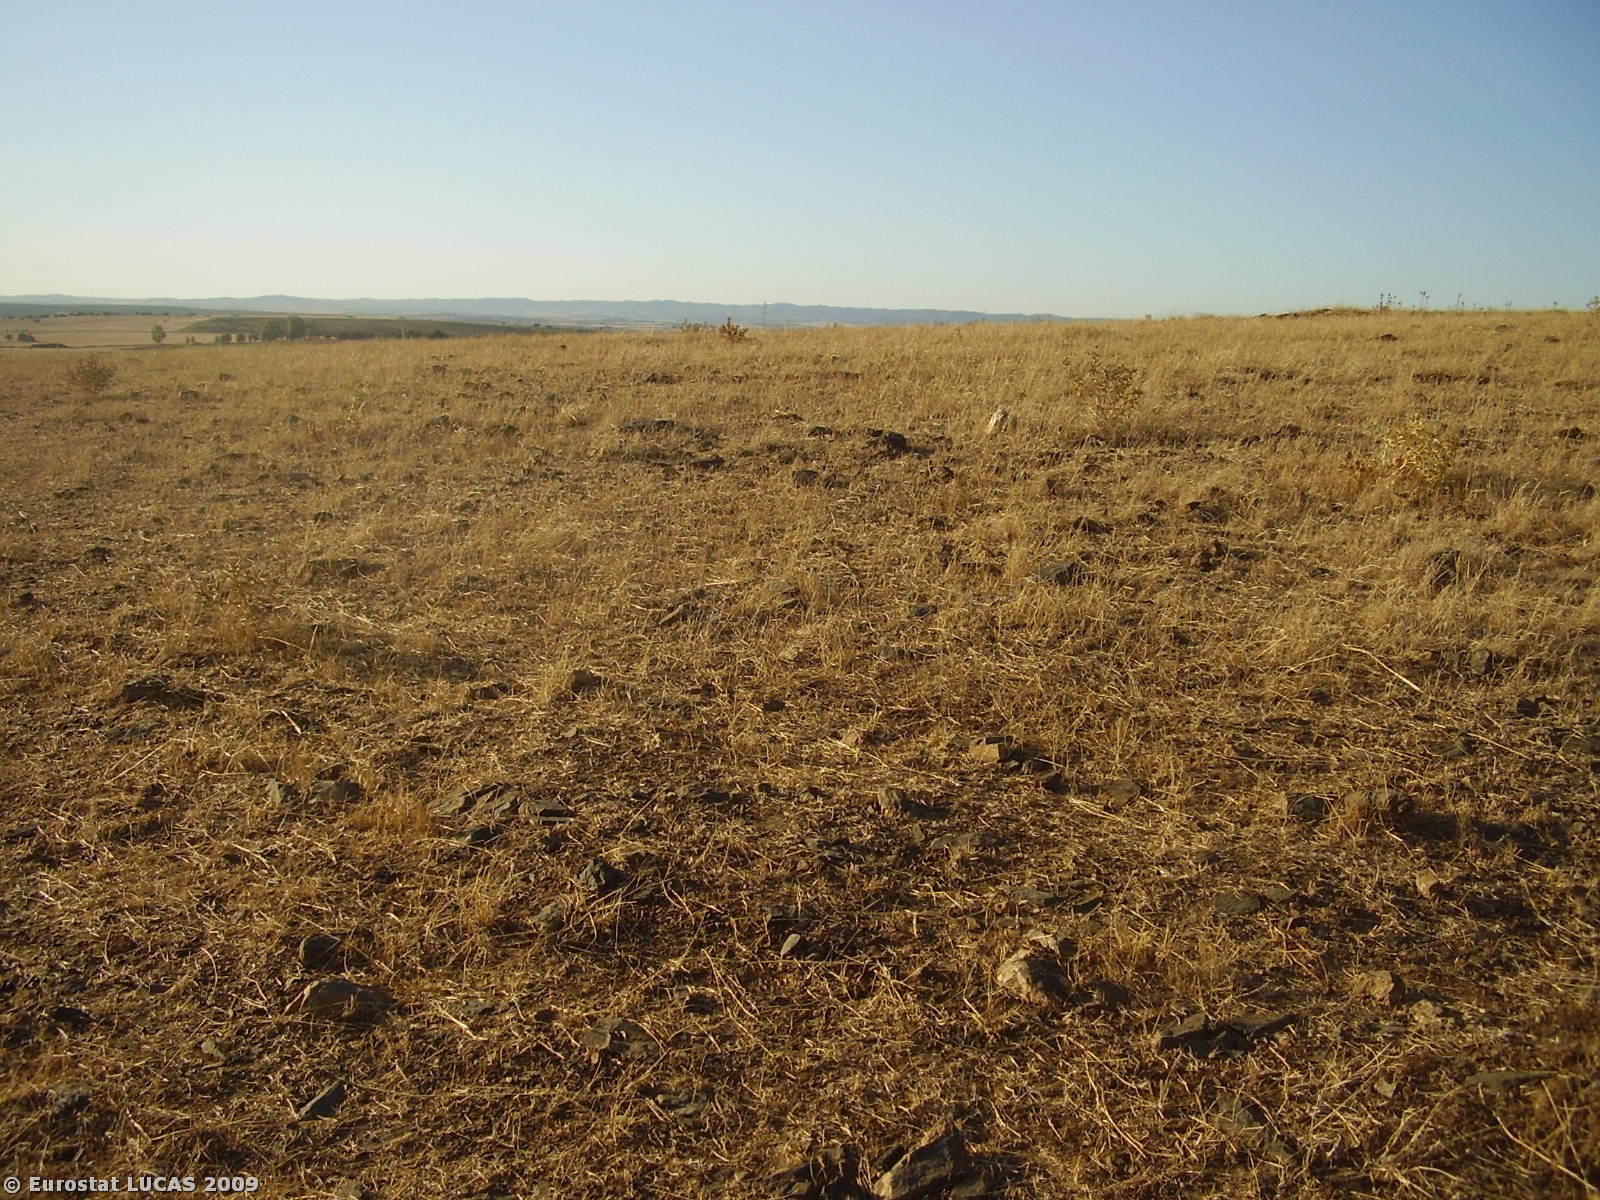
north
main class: Grassland
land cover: Grassland without tree/shrub cover
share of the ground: > 75 %
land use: Fallow land
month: July
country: PT
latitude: 38.0480
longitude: -7.7221
